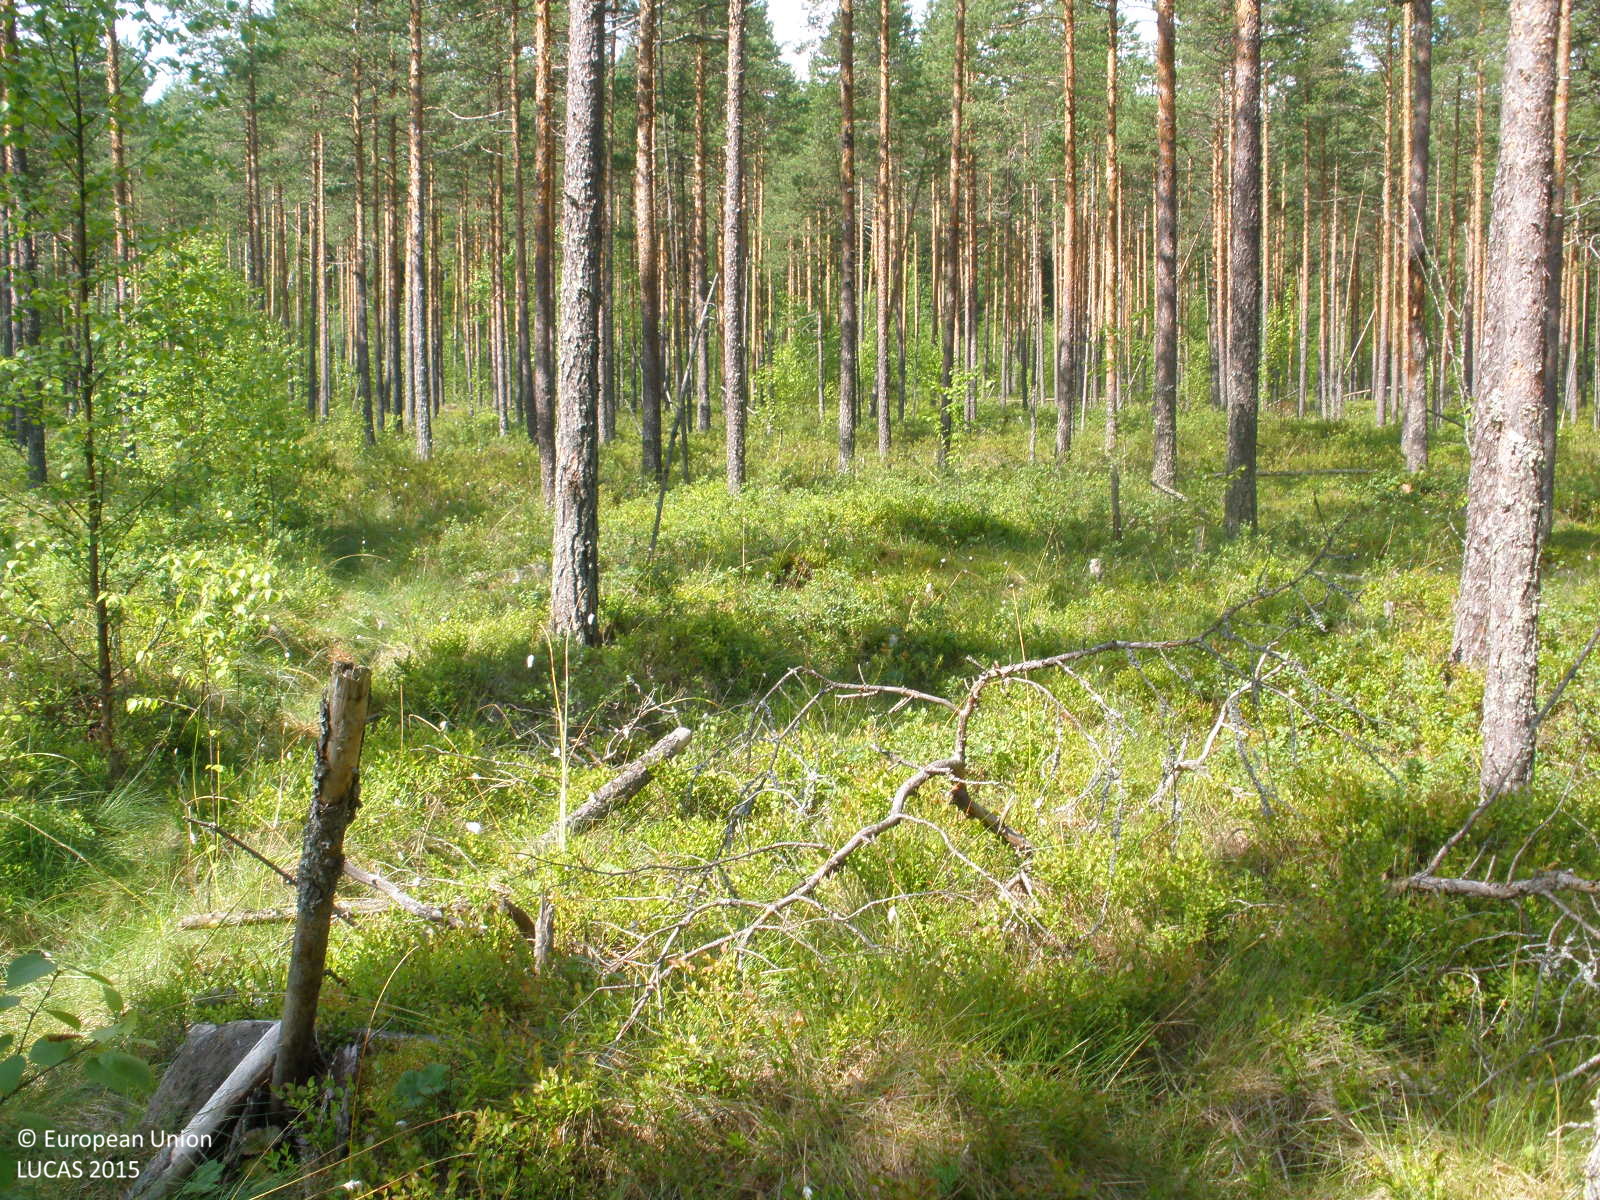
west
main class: Woodland
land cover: Pine dominated coniferous woodland
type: boreal forest
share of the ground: 50 - 75 %
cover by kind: coniferous forest trees 70 %, lichens and mosses 15 %, shrubs 10 %, herbaceous plants 5 %
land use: Forestry
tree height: > 5 m
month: July
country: FI
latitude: 61.5265
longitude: 24.7894
